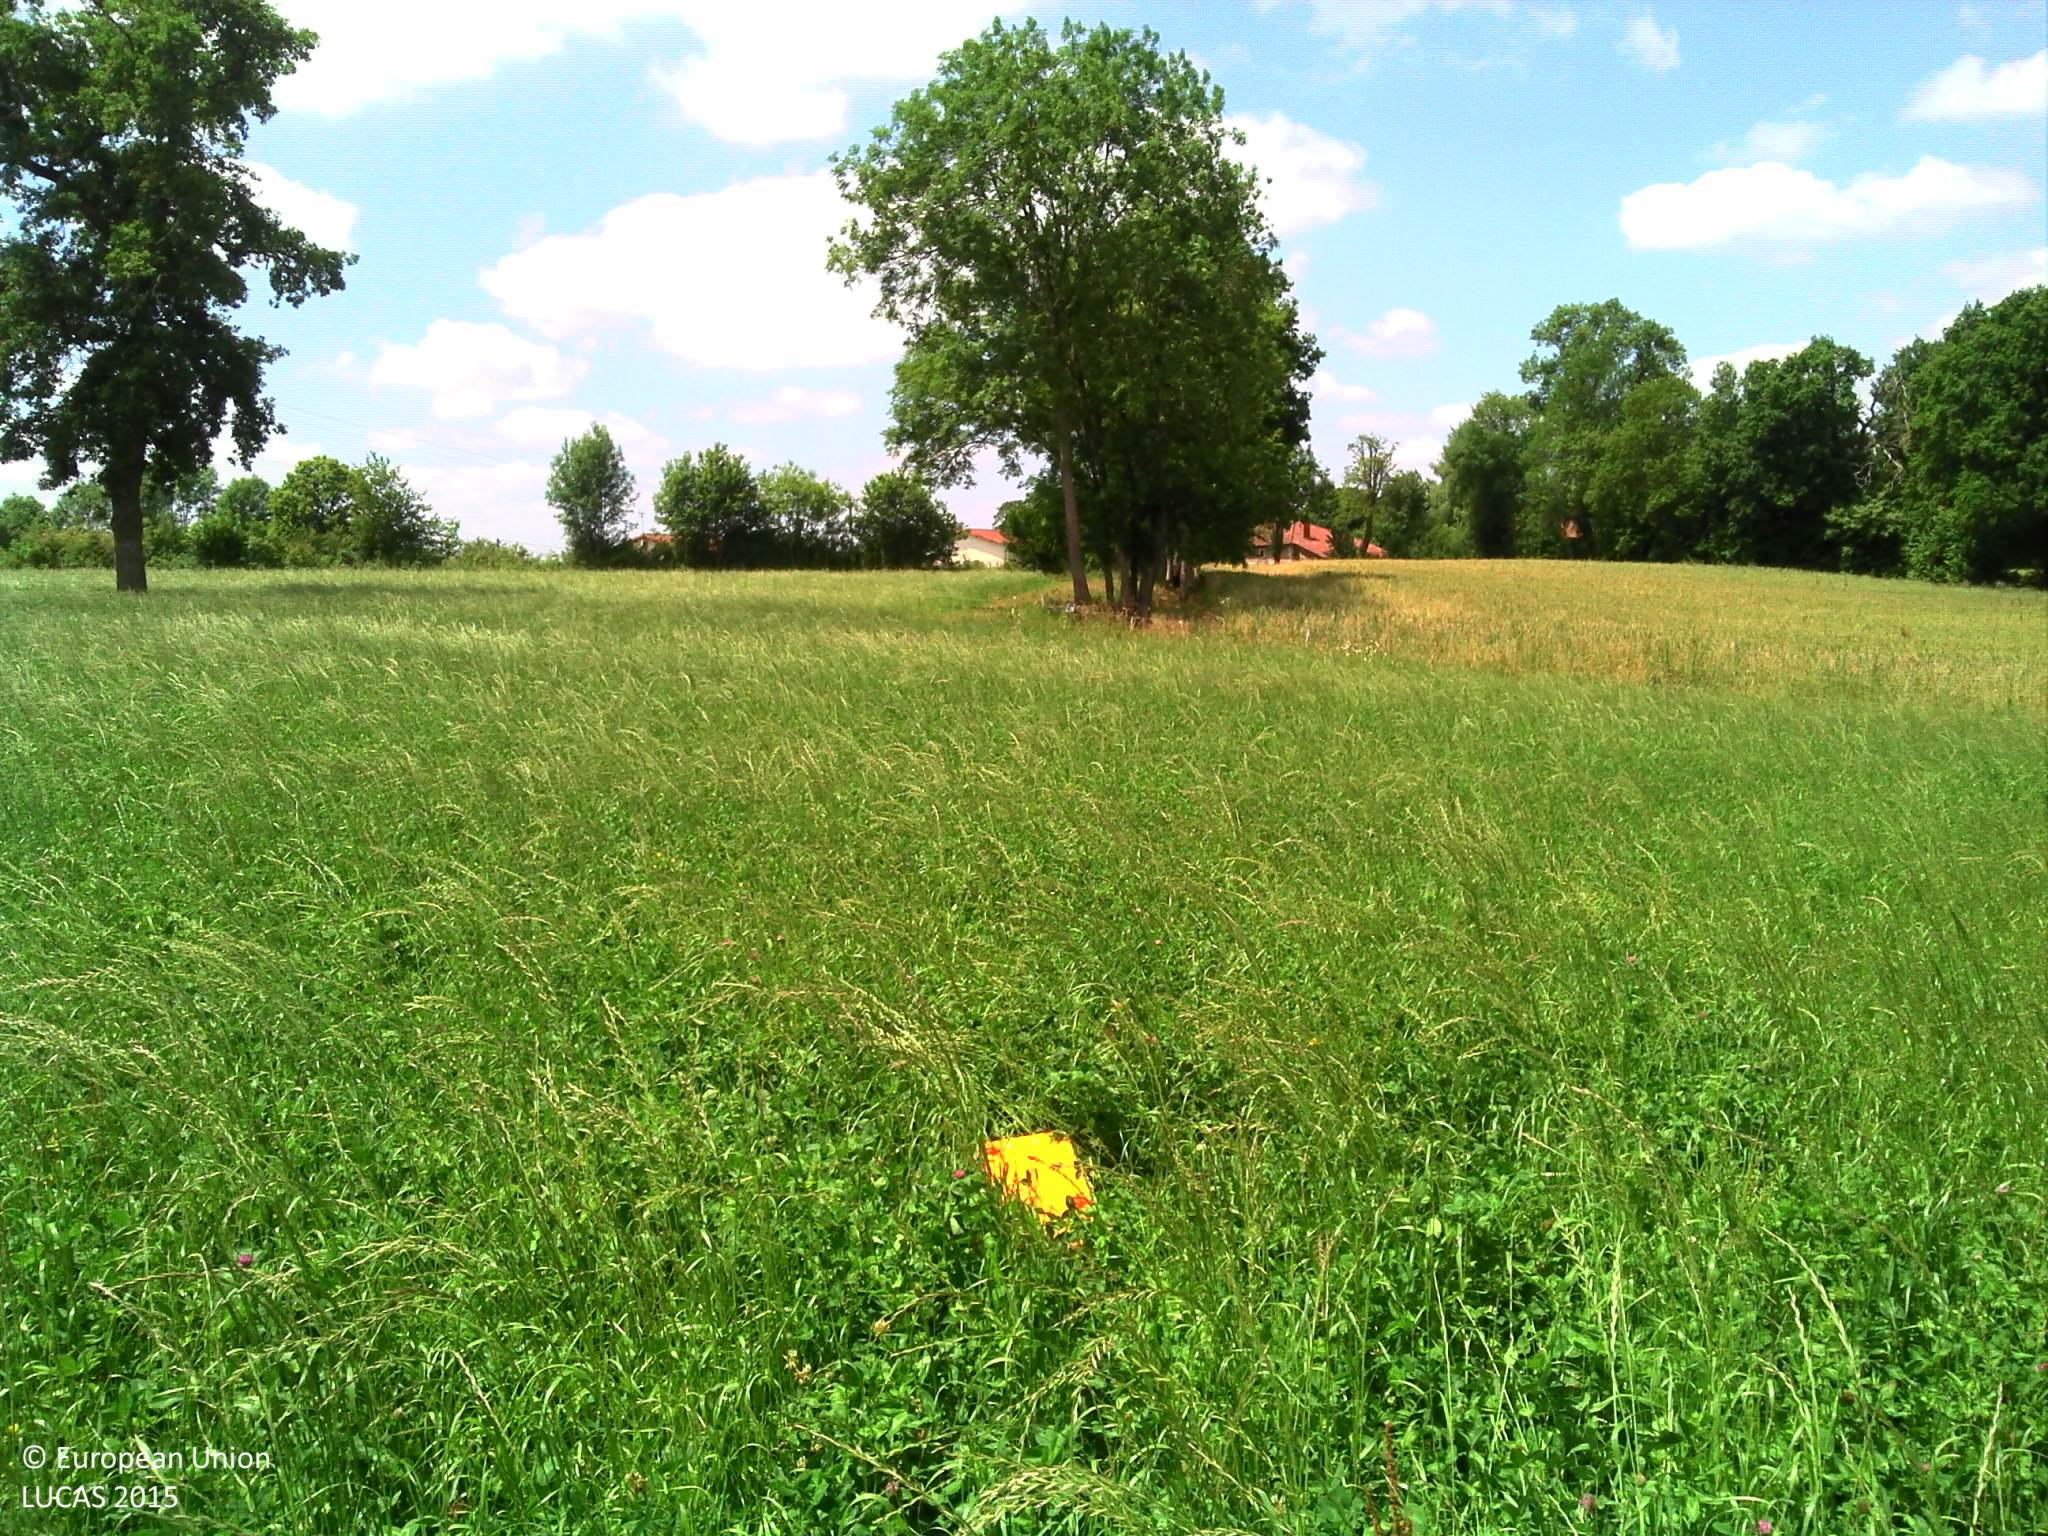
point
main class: Cropland
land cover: Temporary grasslands
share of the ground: > 75 %
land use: Agriculture (excluding fallow land and kitchen gardens)
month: June
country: FR
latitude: 45.9775
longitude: 0.6541
